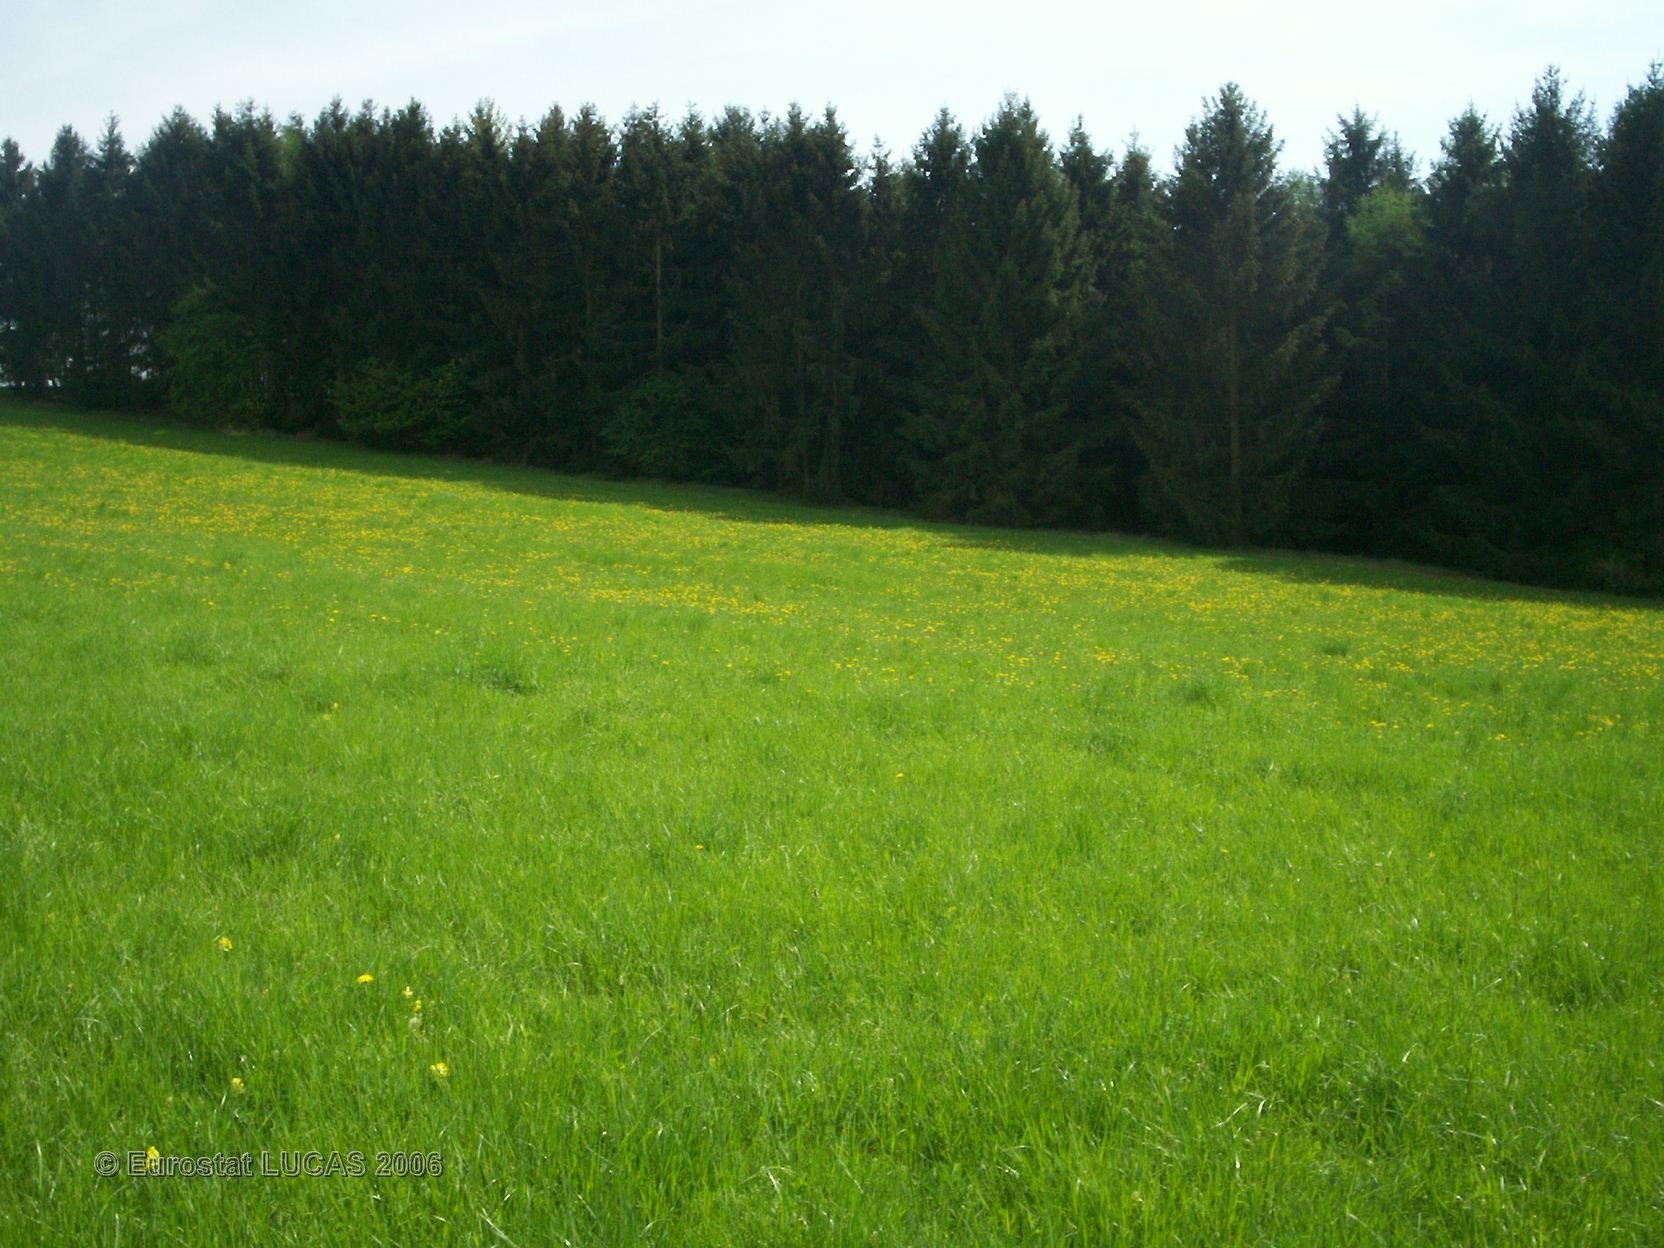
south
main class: Grassland
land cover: Grassland without tree/shrub cover
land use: Agriculture (excluding fallow land and kitchen gardens)
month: May
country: FR
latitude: 49.0665
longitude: 7.0577
